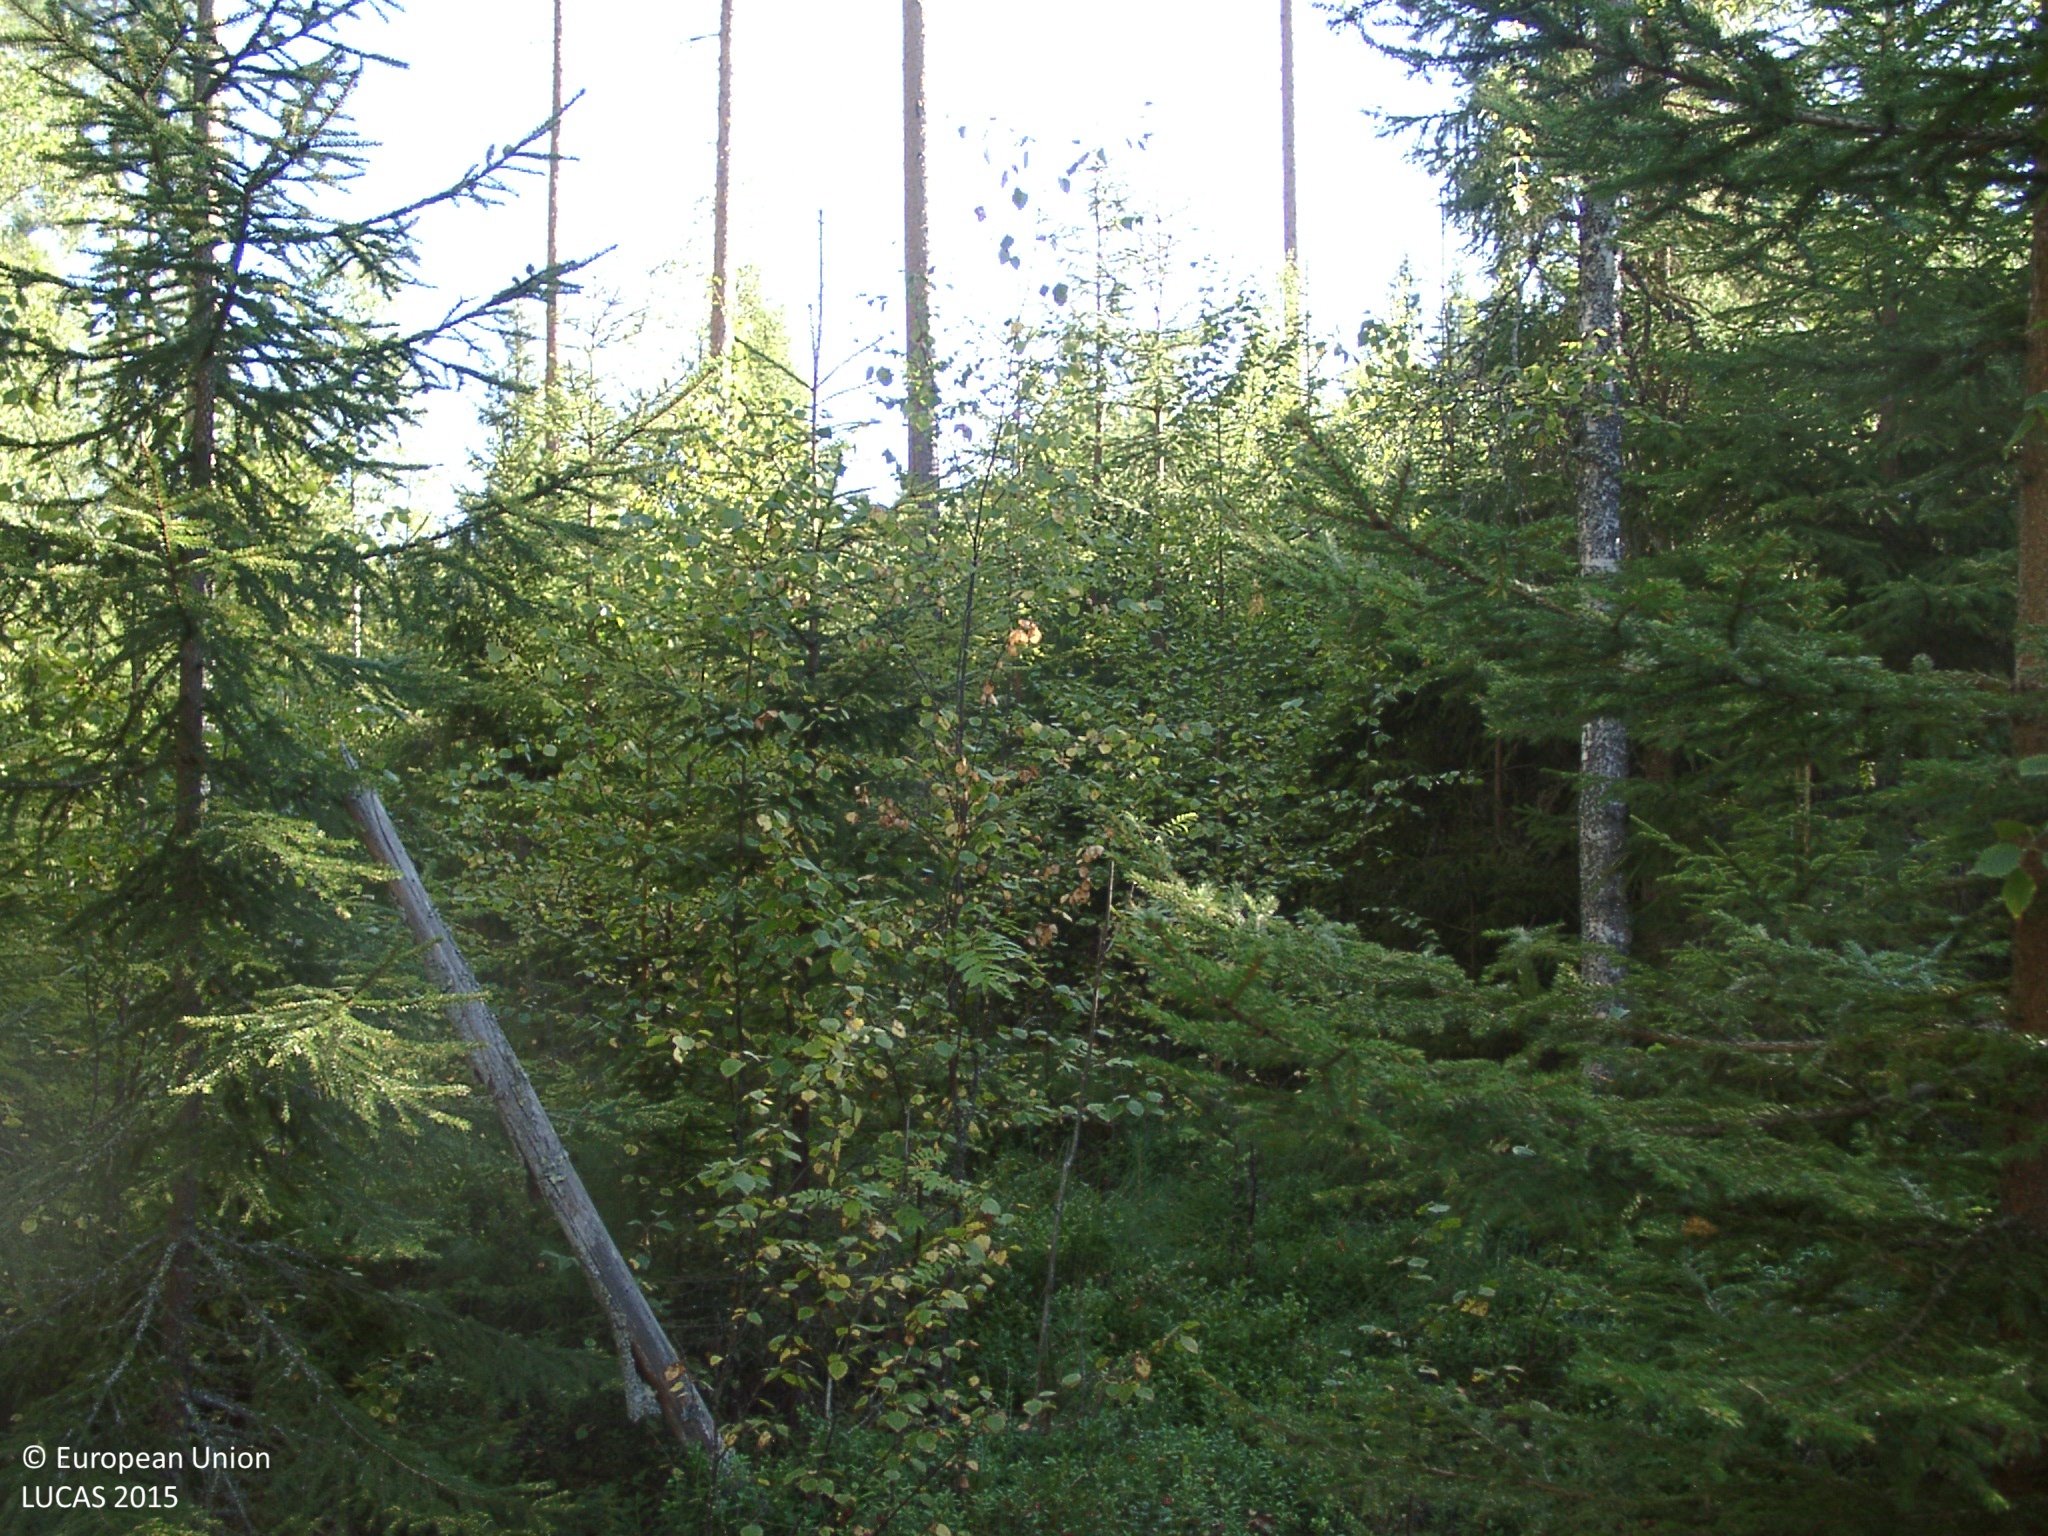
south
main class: Woodland
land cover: Other mixed woodland
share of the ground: 50 - 75 %
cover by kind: coniferous forest trees 50 %, broadleaved forest trees 20 %, shrubs 20 %, herbaceous plants 5 %, lichens and mosses 5 %
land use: Forestry
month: August
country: FI
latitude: 61.9978
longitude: 24.8603
